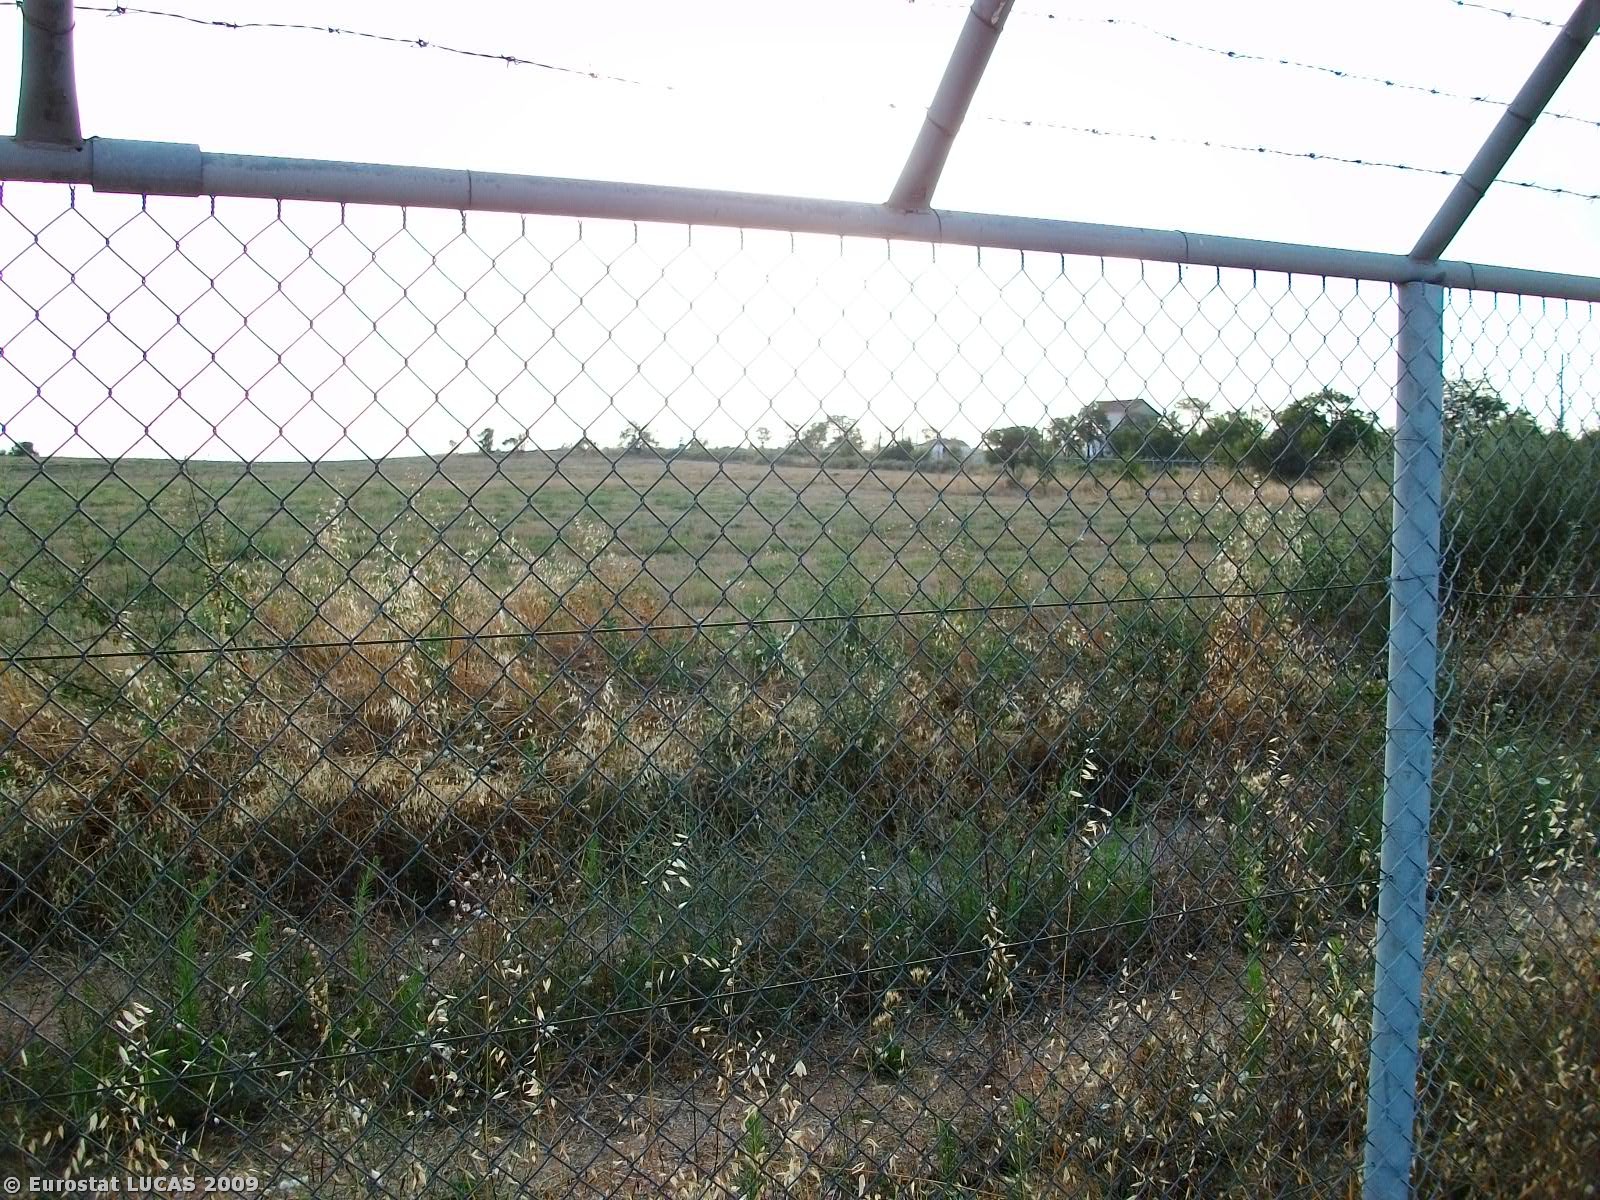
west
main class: Grassland
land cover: Spontaneously vegetated surfaces
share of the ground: > 75 %
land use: Fallow land
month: July
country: GR
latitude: 40.2966
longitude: 21.8389
